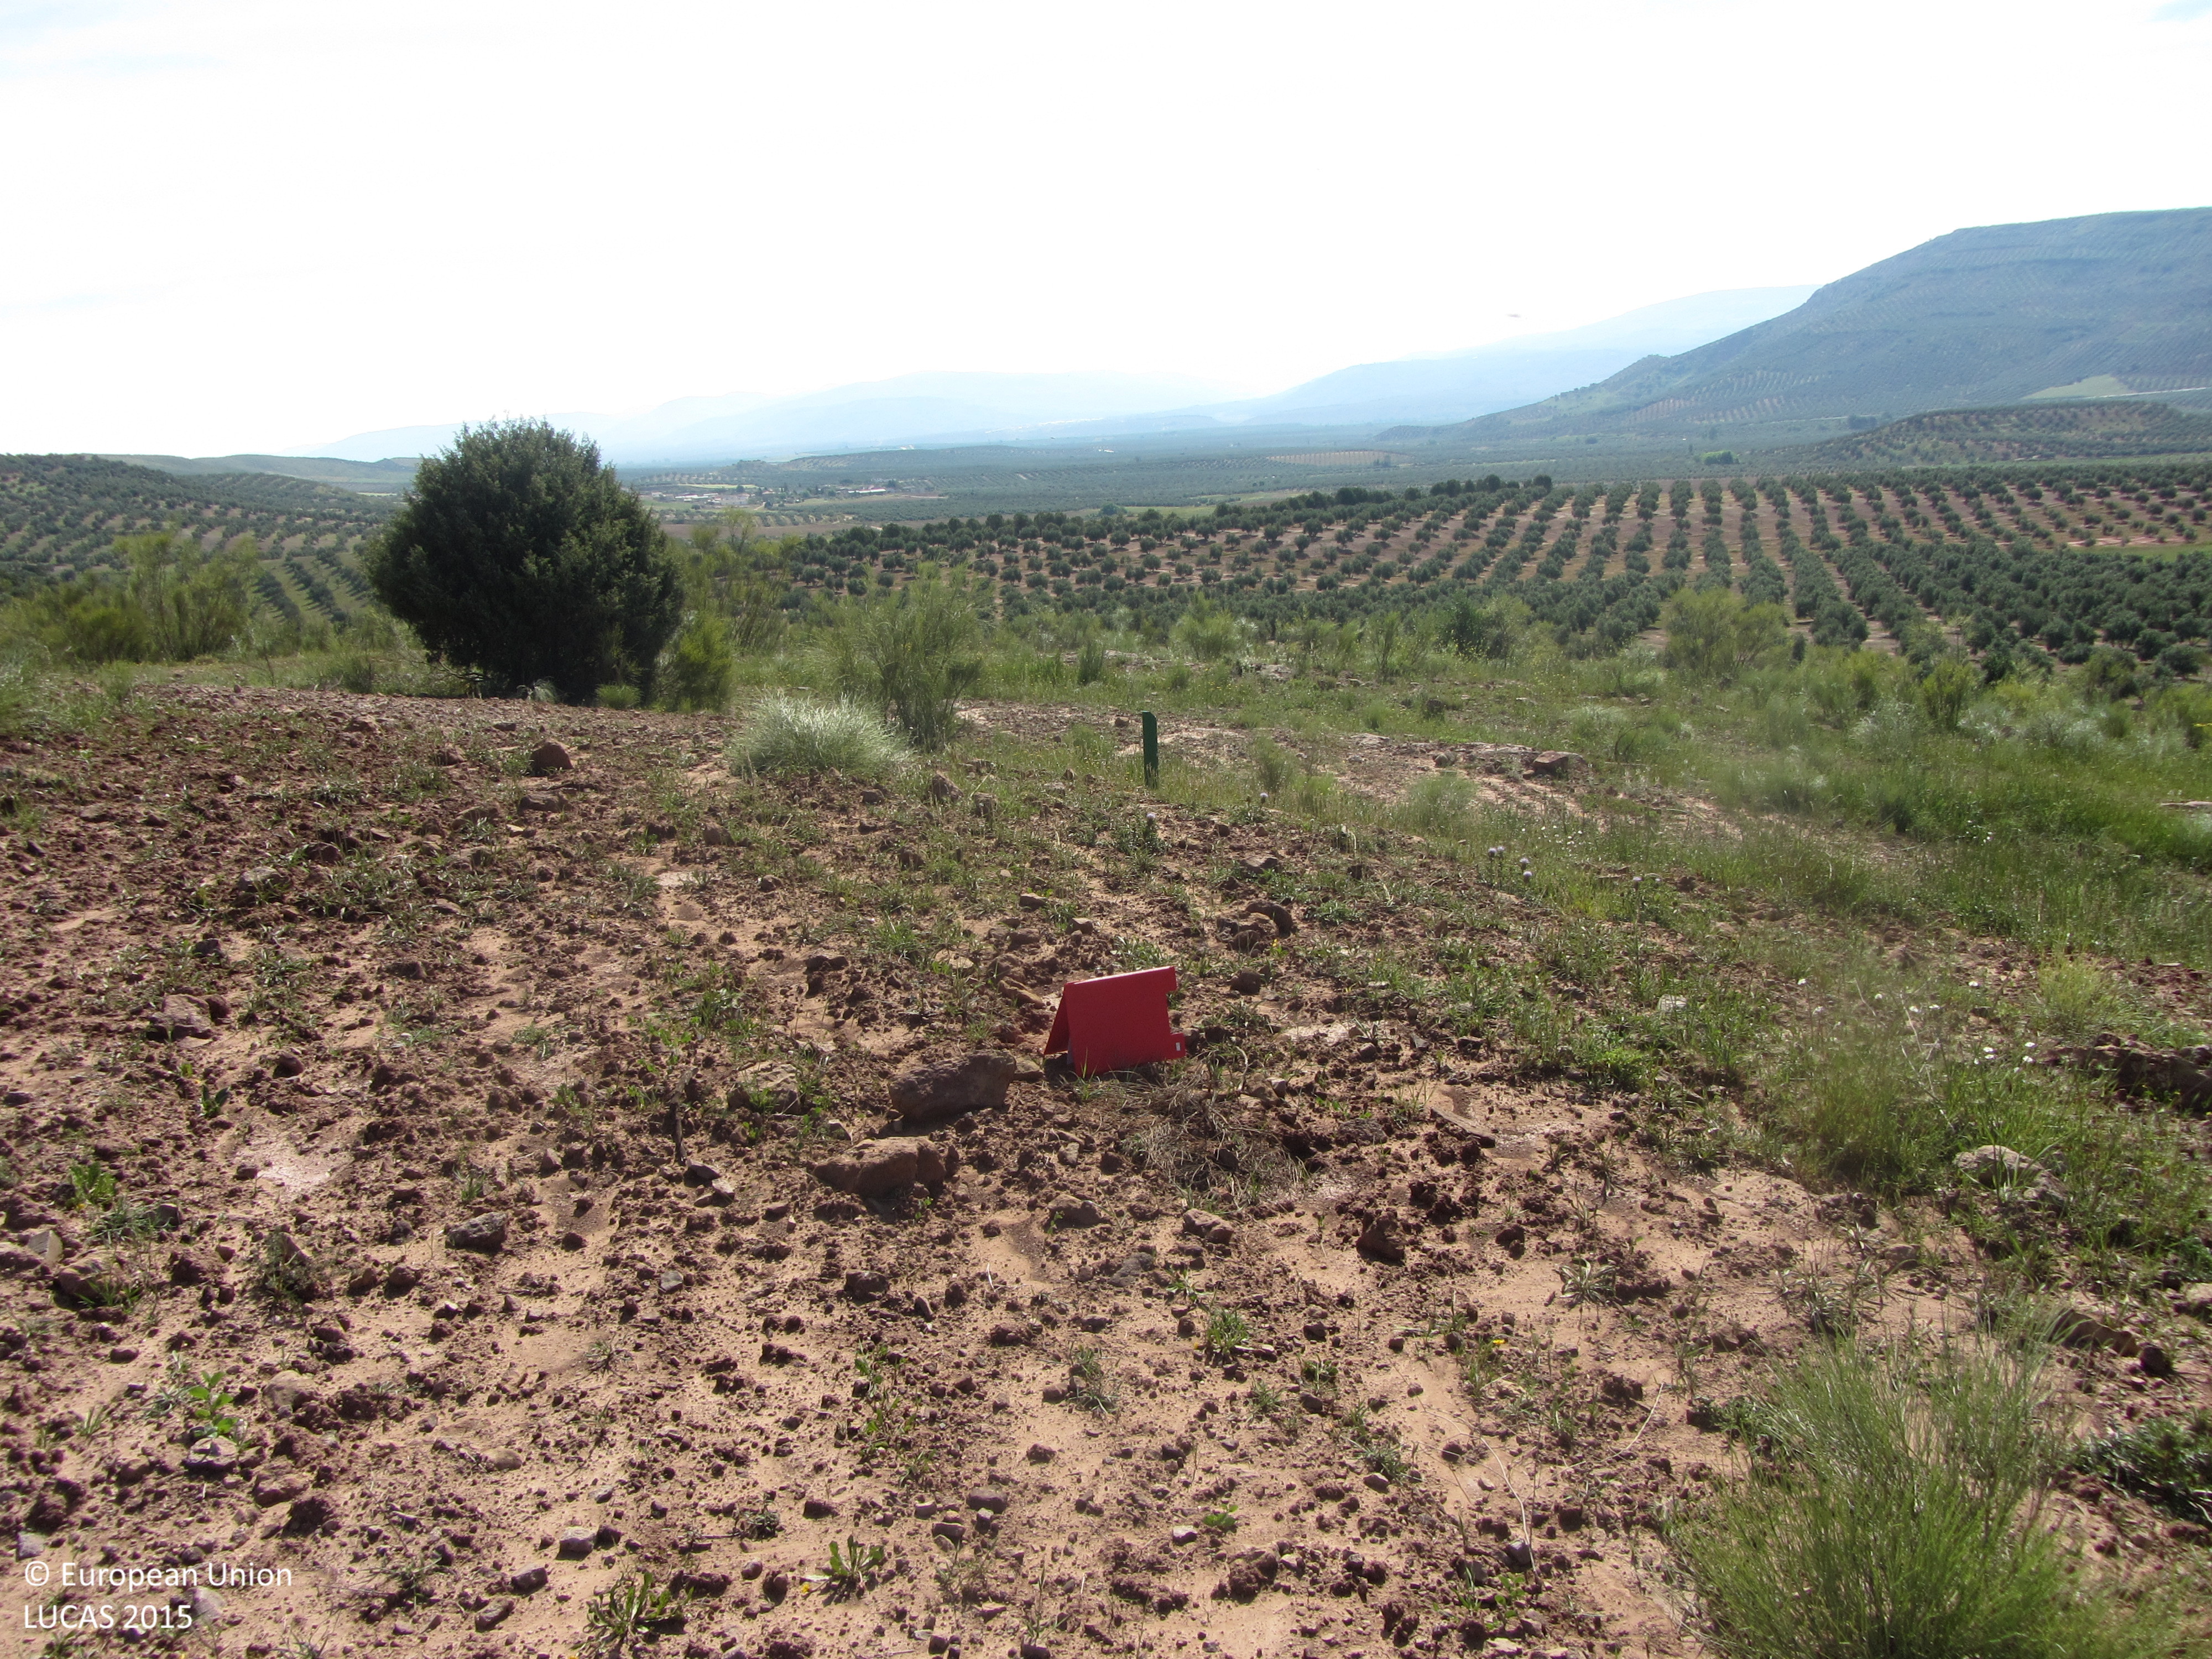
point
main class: Grassland
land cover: Spontaneously vegetated surfaces
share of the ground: 25 - 50 %
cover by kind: consolidated bare surface 65 %, herbaceous plants 35 %
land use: Semi-natural and natural areas not in use
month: May
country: ES
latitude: 38.2722
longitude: -3.0658
